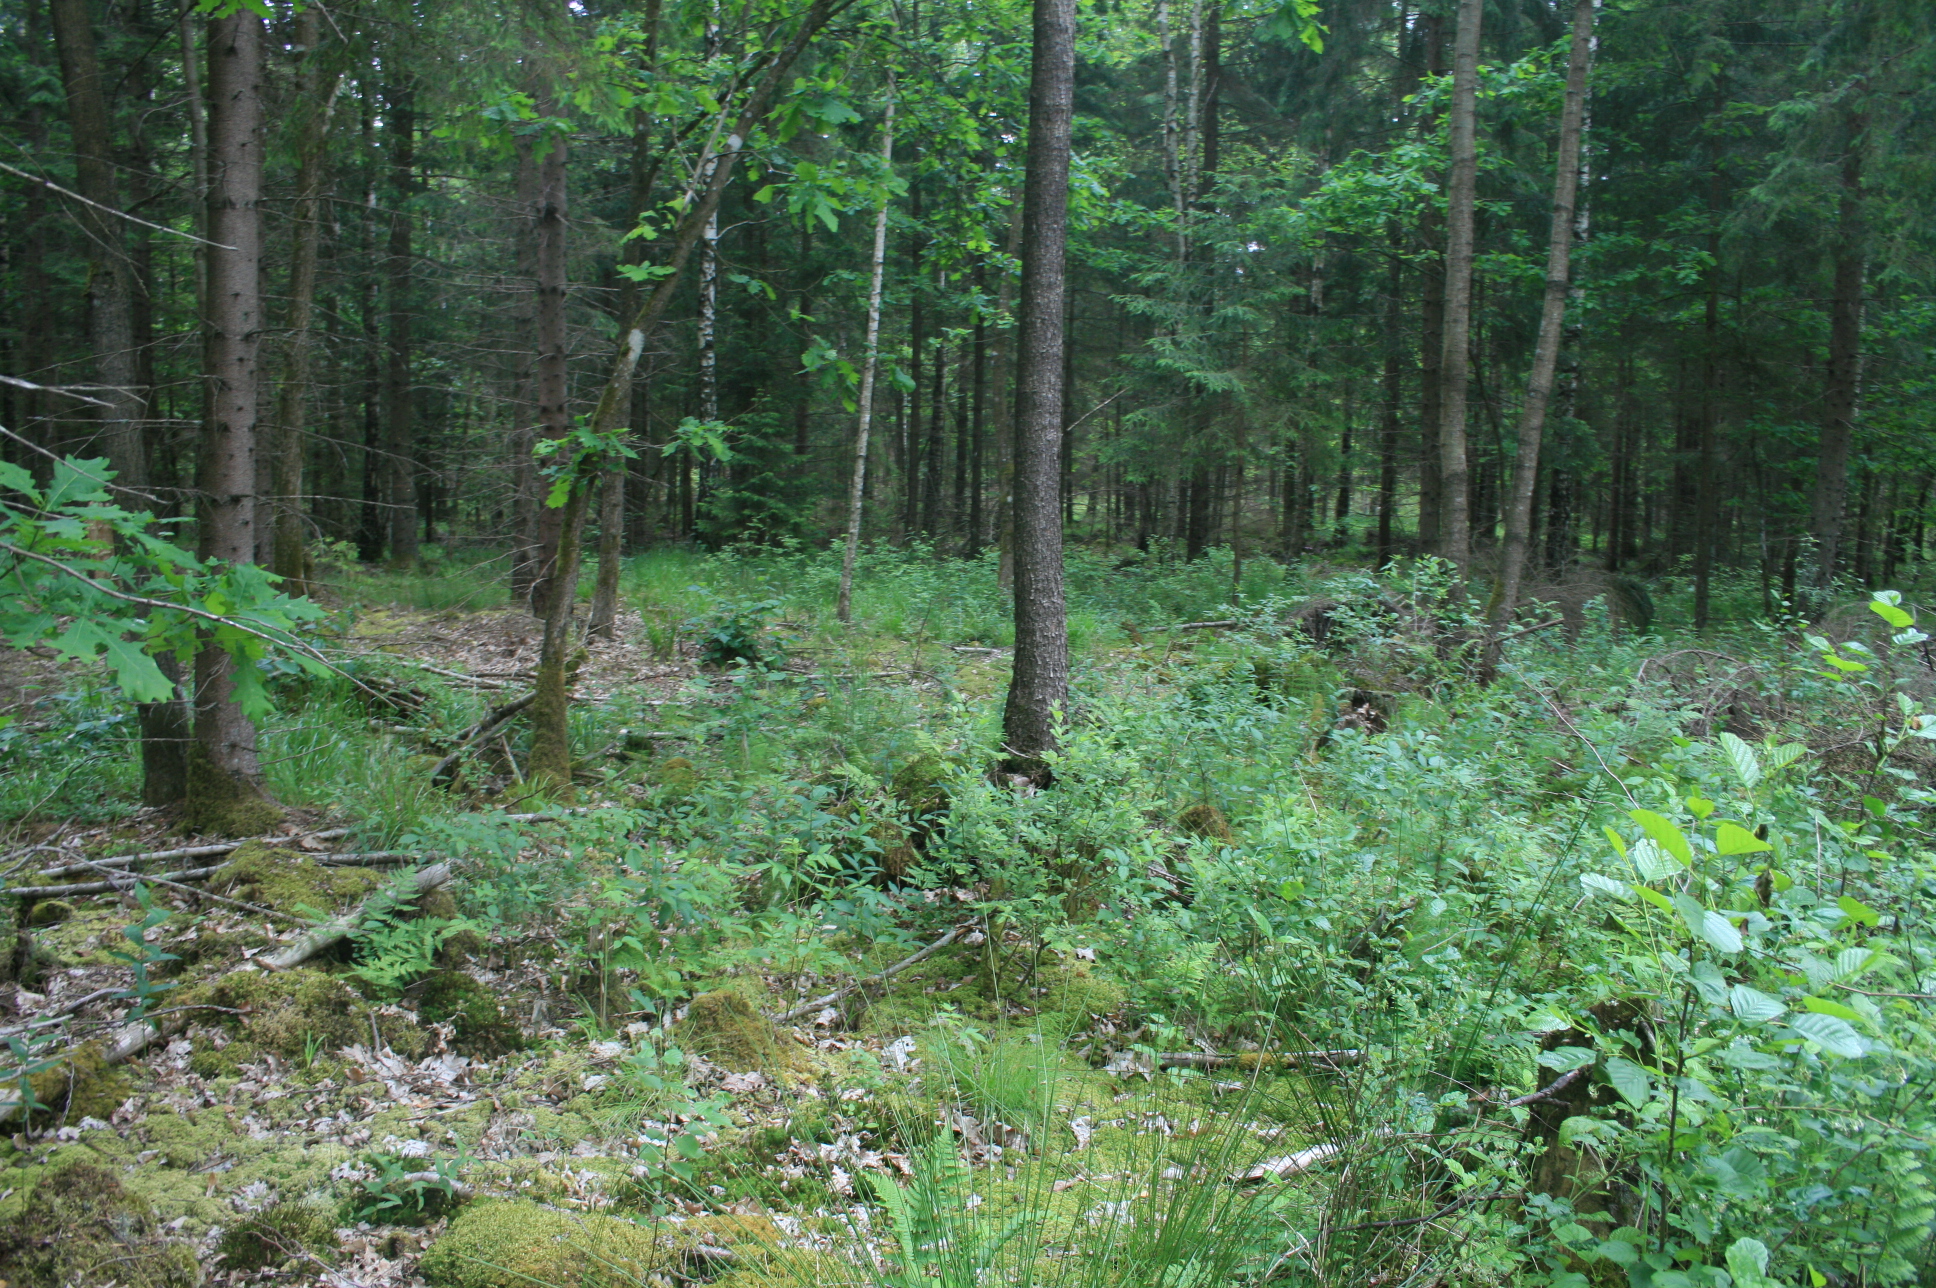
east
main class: Woodland
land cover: Spruce dominated mixed woodland
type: hemiboreal forest and nemoral coniferous forest and mixed broadleaved-coniferous forest
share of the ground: > 75 %
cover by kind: coniferous forest trees 65 %, broadleaved forest trees 30 %, herbaceous plants 5 %
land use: Forestry
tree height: > 5 m
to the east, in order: Spruce dominated mixed woodland
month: June
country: LT
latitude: 55.3203
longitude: 22.1109
